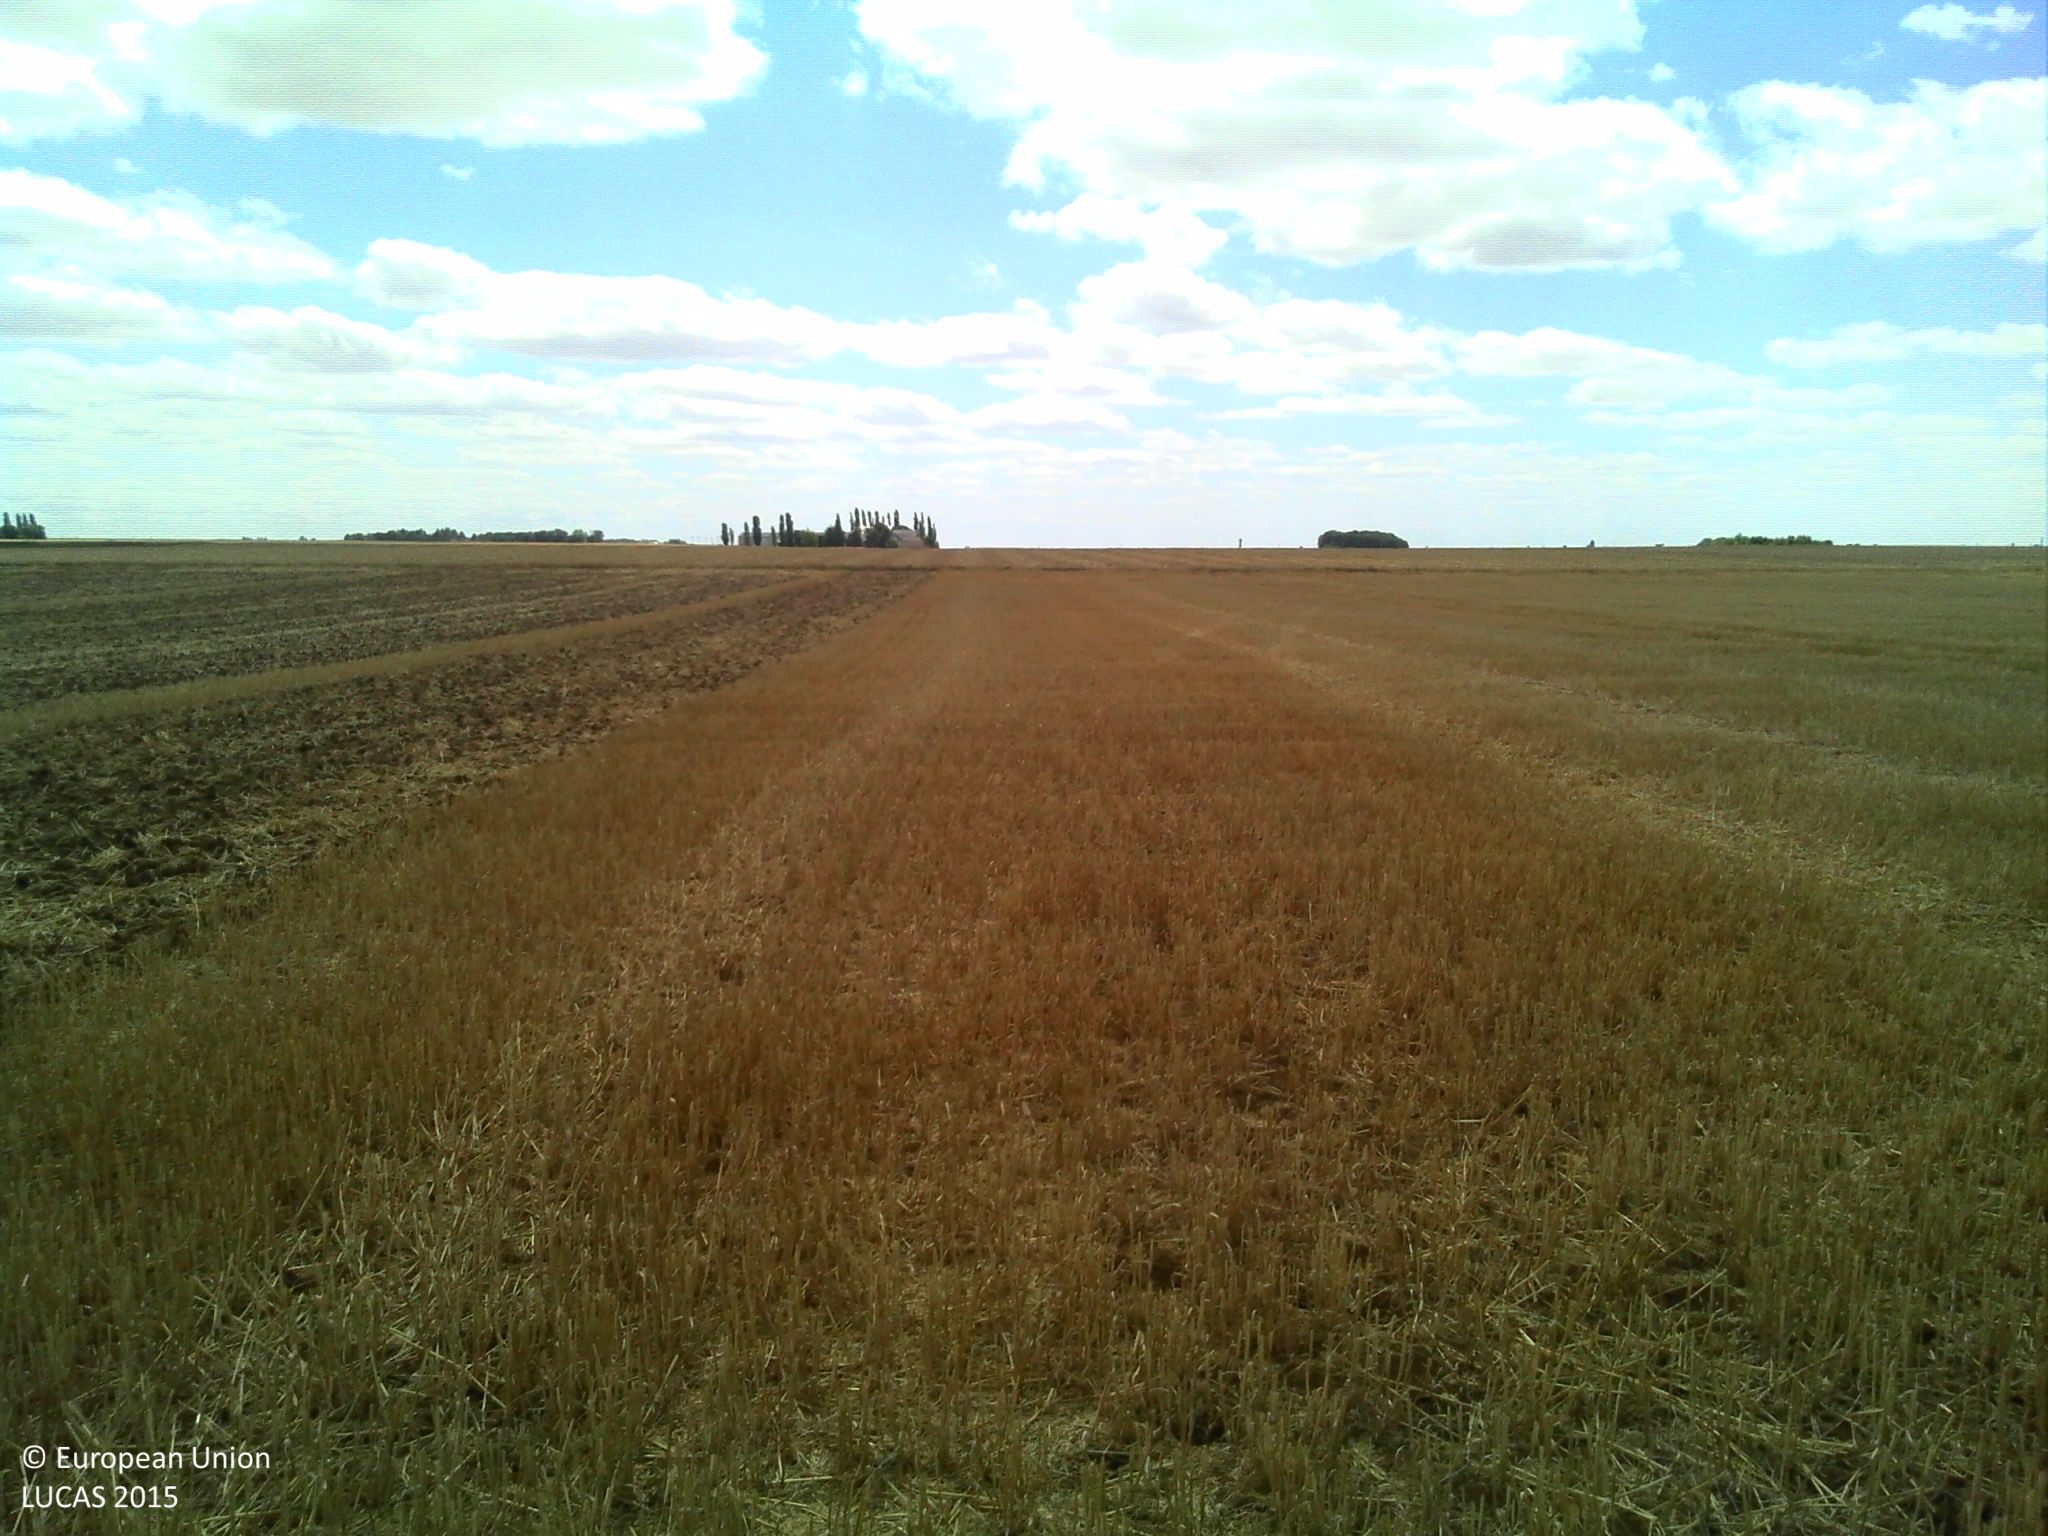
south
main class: Cropland
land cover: Common wheat
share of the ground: > 75 %
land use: Agriculture (excluding fallow land and kitchen gardens)
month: August
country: FR
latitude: 48.2579
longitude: 1.9995
